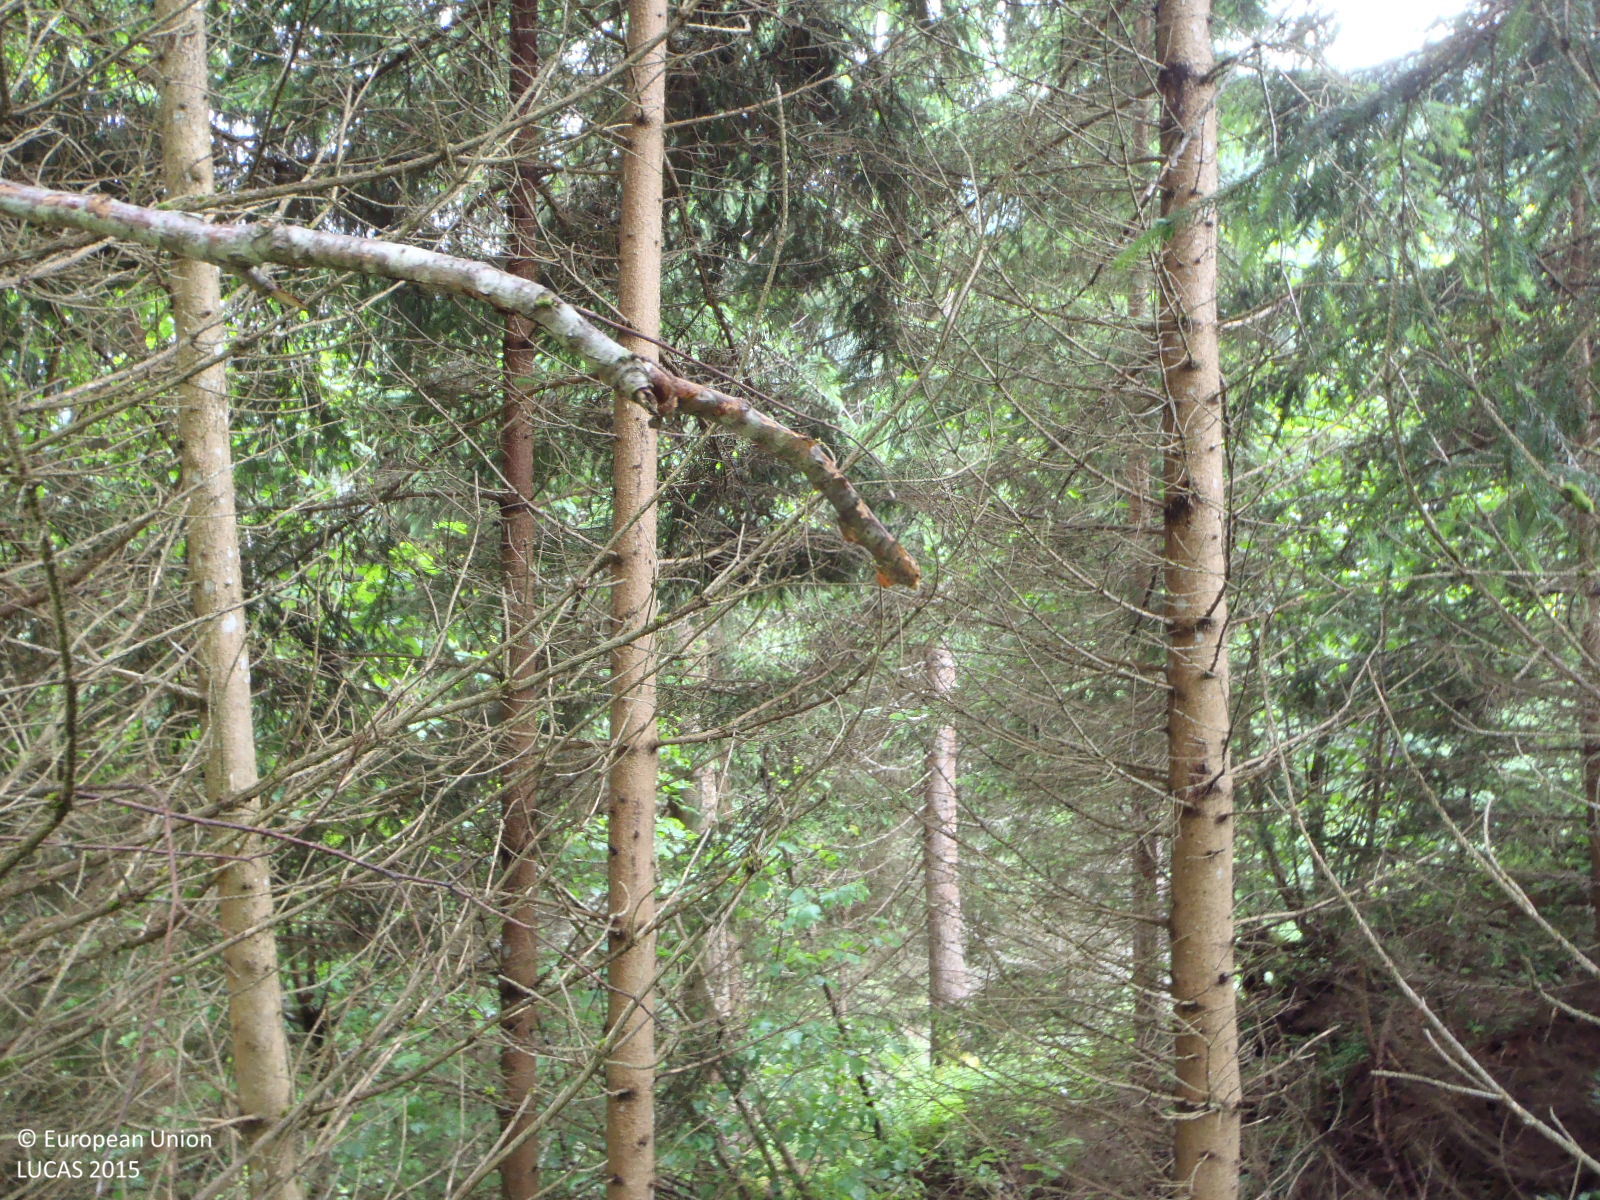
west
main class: Woodland
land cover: Spruce dominated coniferous woodland
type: alpine coniferous forest
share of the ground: > 75 %
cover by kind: coniferous forest trees 65 %, broadleaved forest trees 20 %, herbaceous plants 15 %
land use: Forestry
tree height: > 5 m
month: June
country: AT
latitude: 47.3791
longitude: 12.7399
